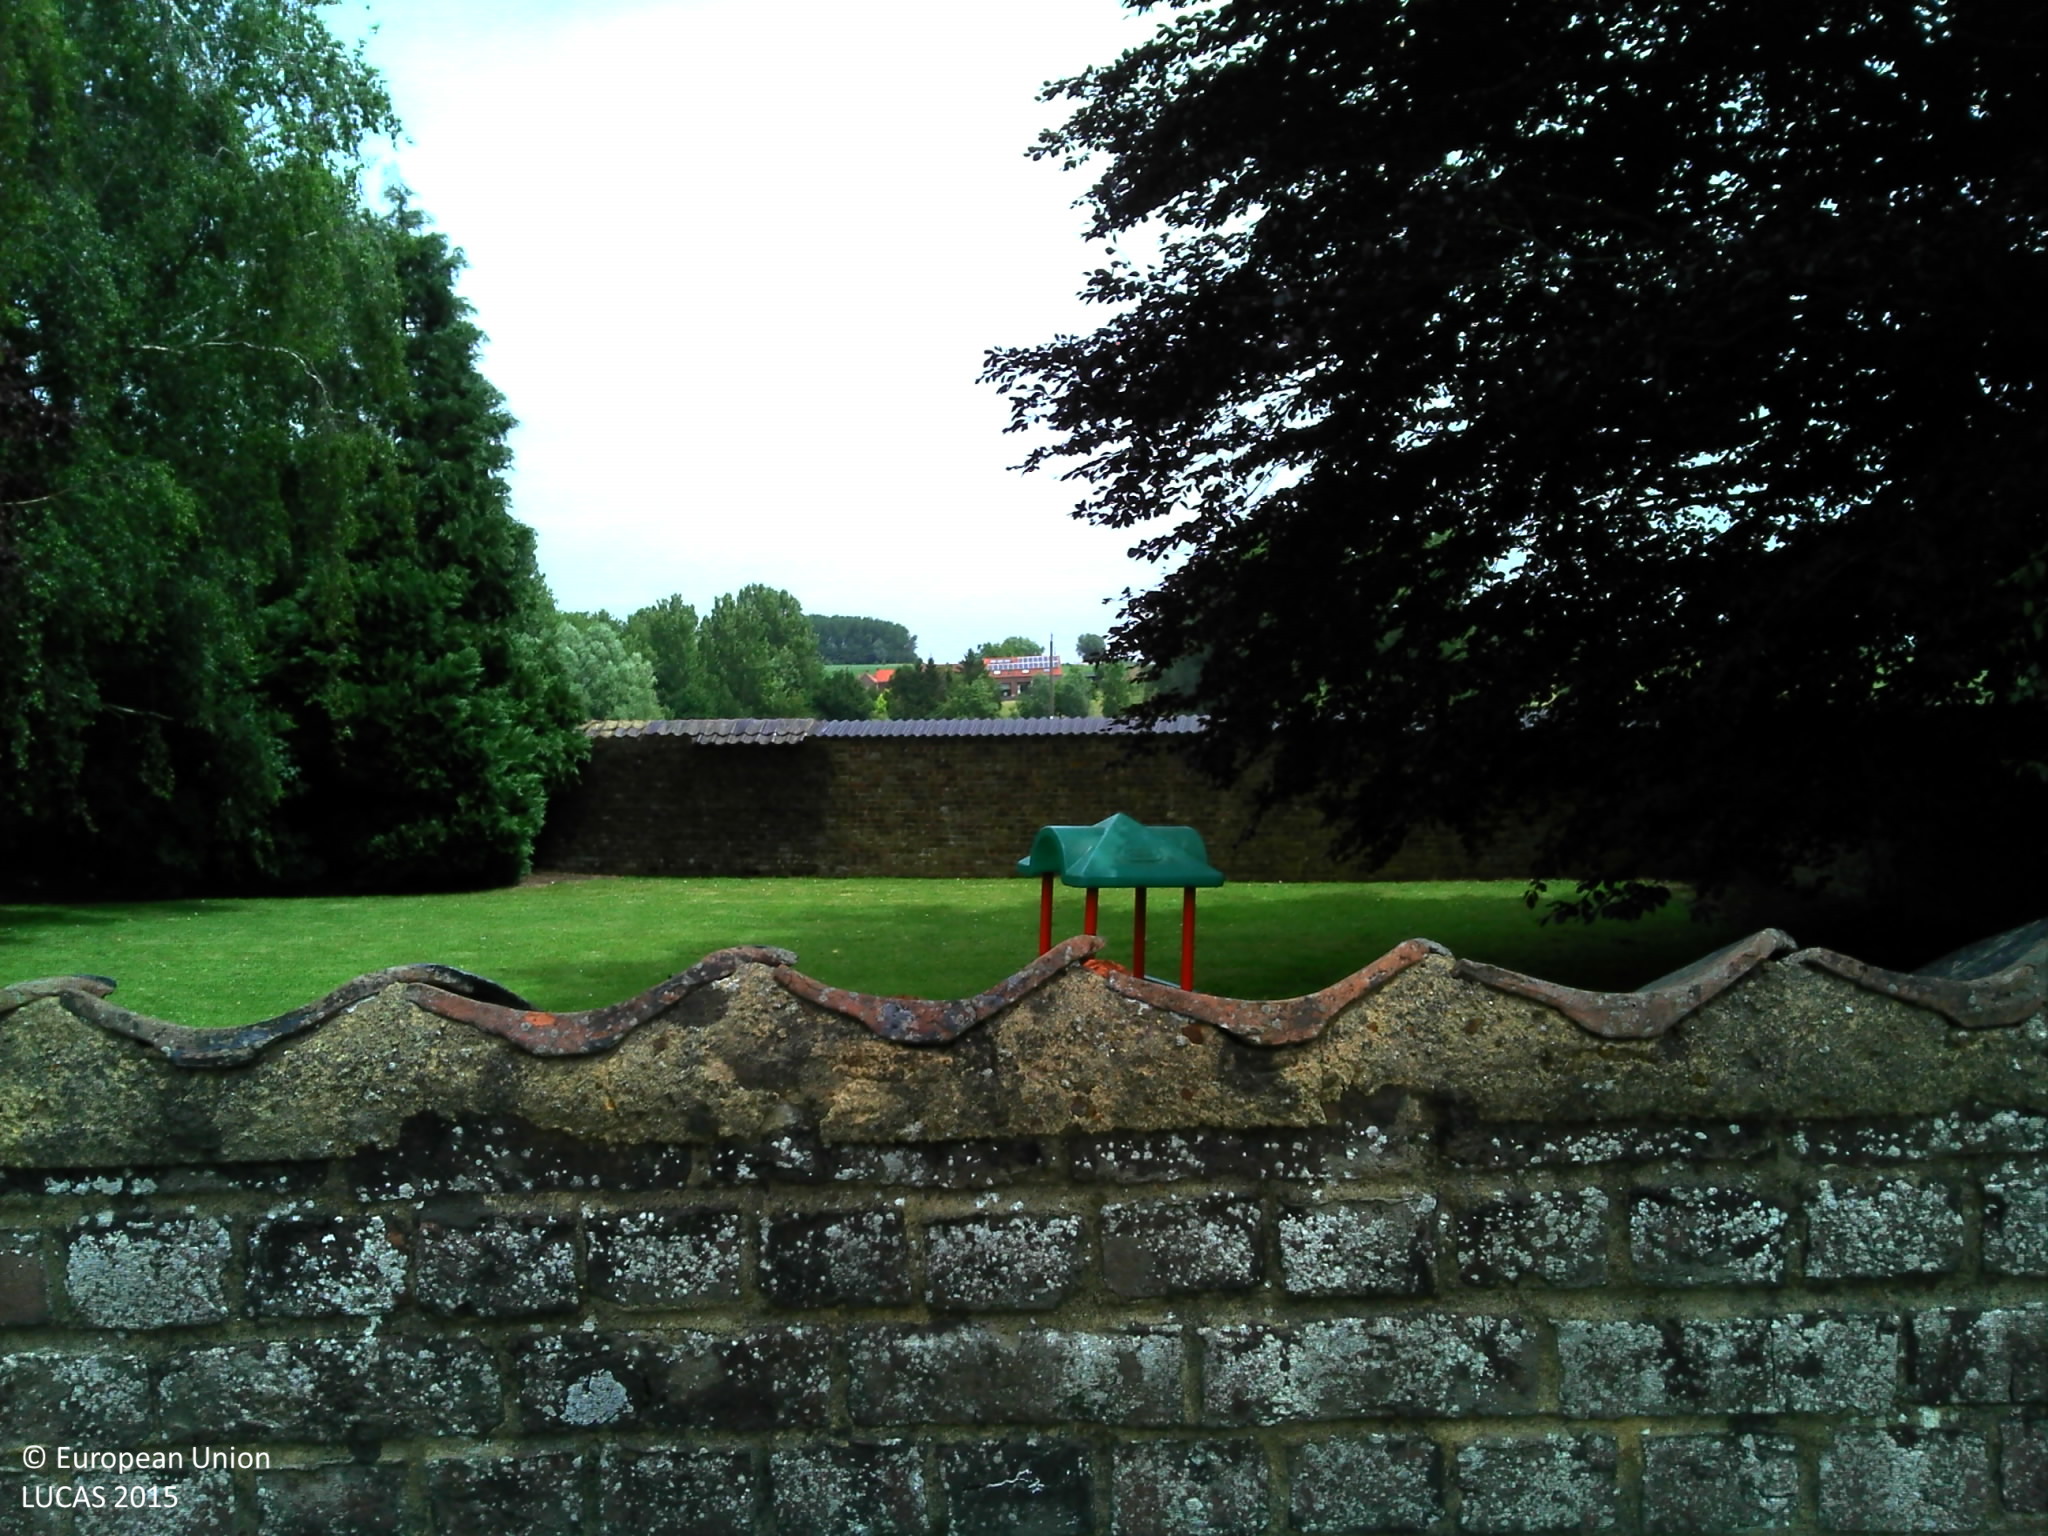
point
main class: Grassland
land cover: Grassland without tree/shrub cover
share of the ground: > 75 %
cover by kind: herbaceous plants 100 %
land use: Amenities, museums, leisure
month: June
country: BE
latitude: 50.6429
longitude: 3.7286
